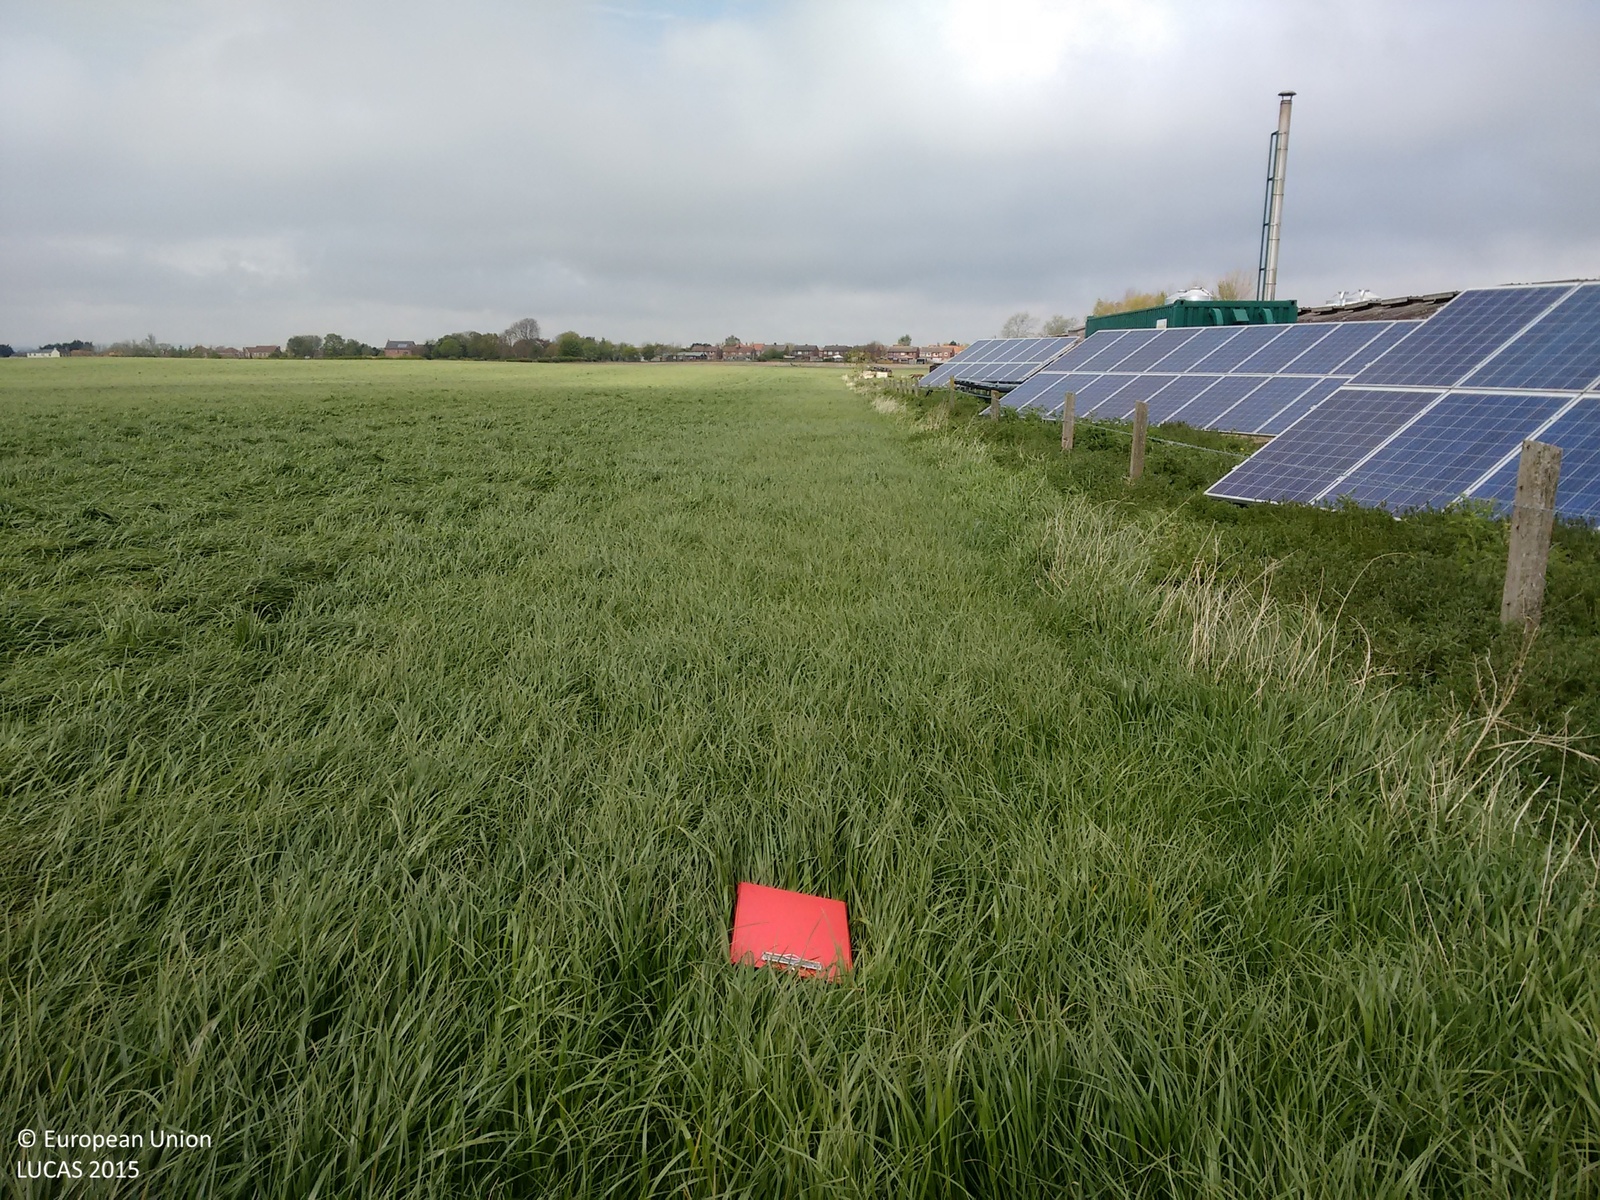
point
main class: Grassland
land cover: Grassland without tree/shrub cover
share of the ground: > 75 %
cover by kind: herbaceous plants 100 %
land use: Agriculture (excluding fallow land and kitchen gardens)
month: May
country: GB
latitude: 53.9569
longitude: -0.3215
